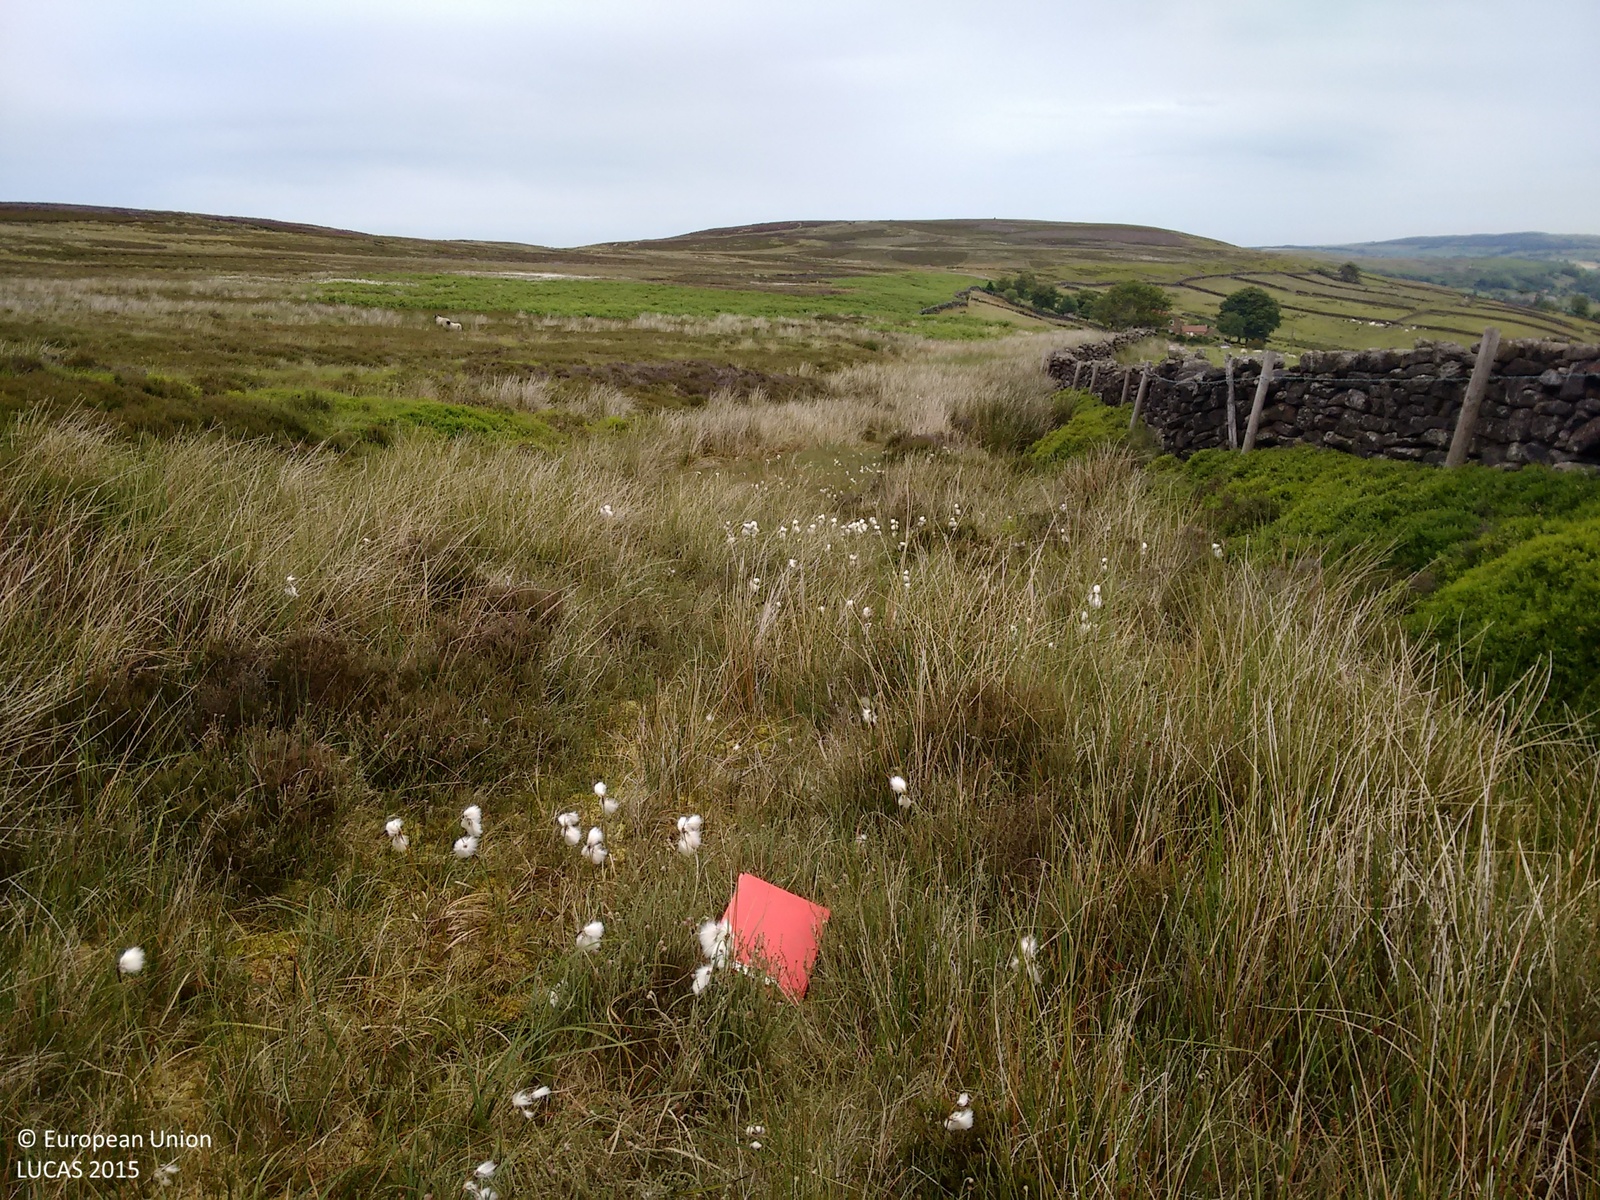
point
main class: Shrubland
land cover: Shrubland without tree cover
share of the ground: > 75 %
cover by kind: shrubs 65 %, herbaceous plants 35 %
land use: Agriculture (excluding fallow land and kitchen gardens)
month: July
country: GB
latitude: 54.4171
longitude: -0.8737
